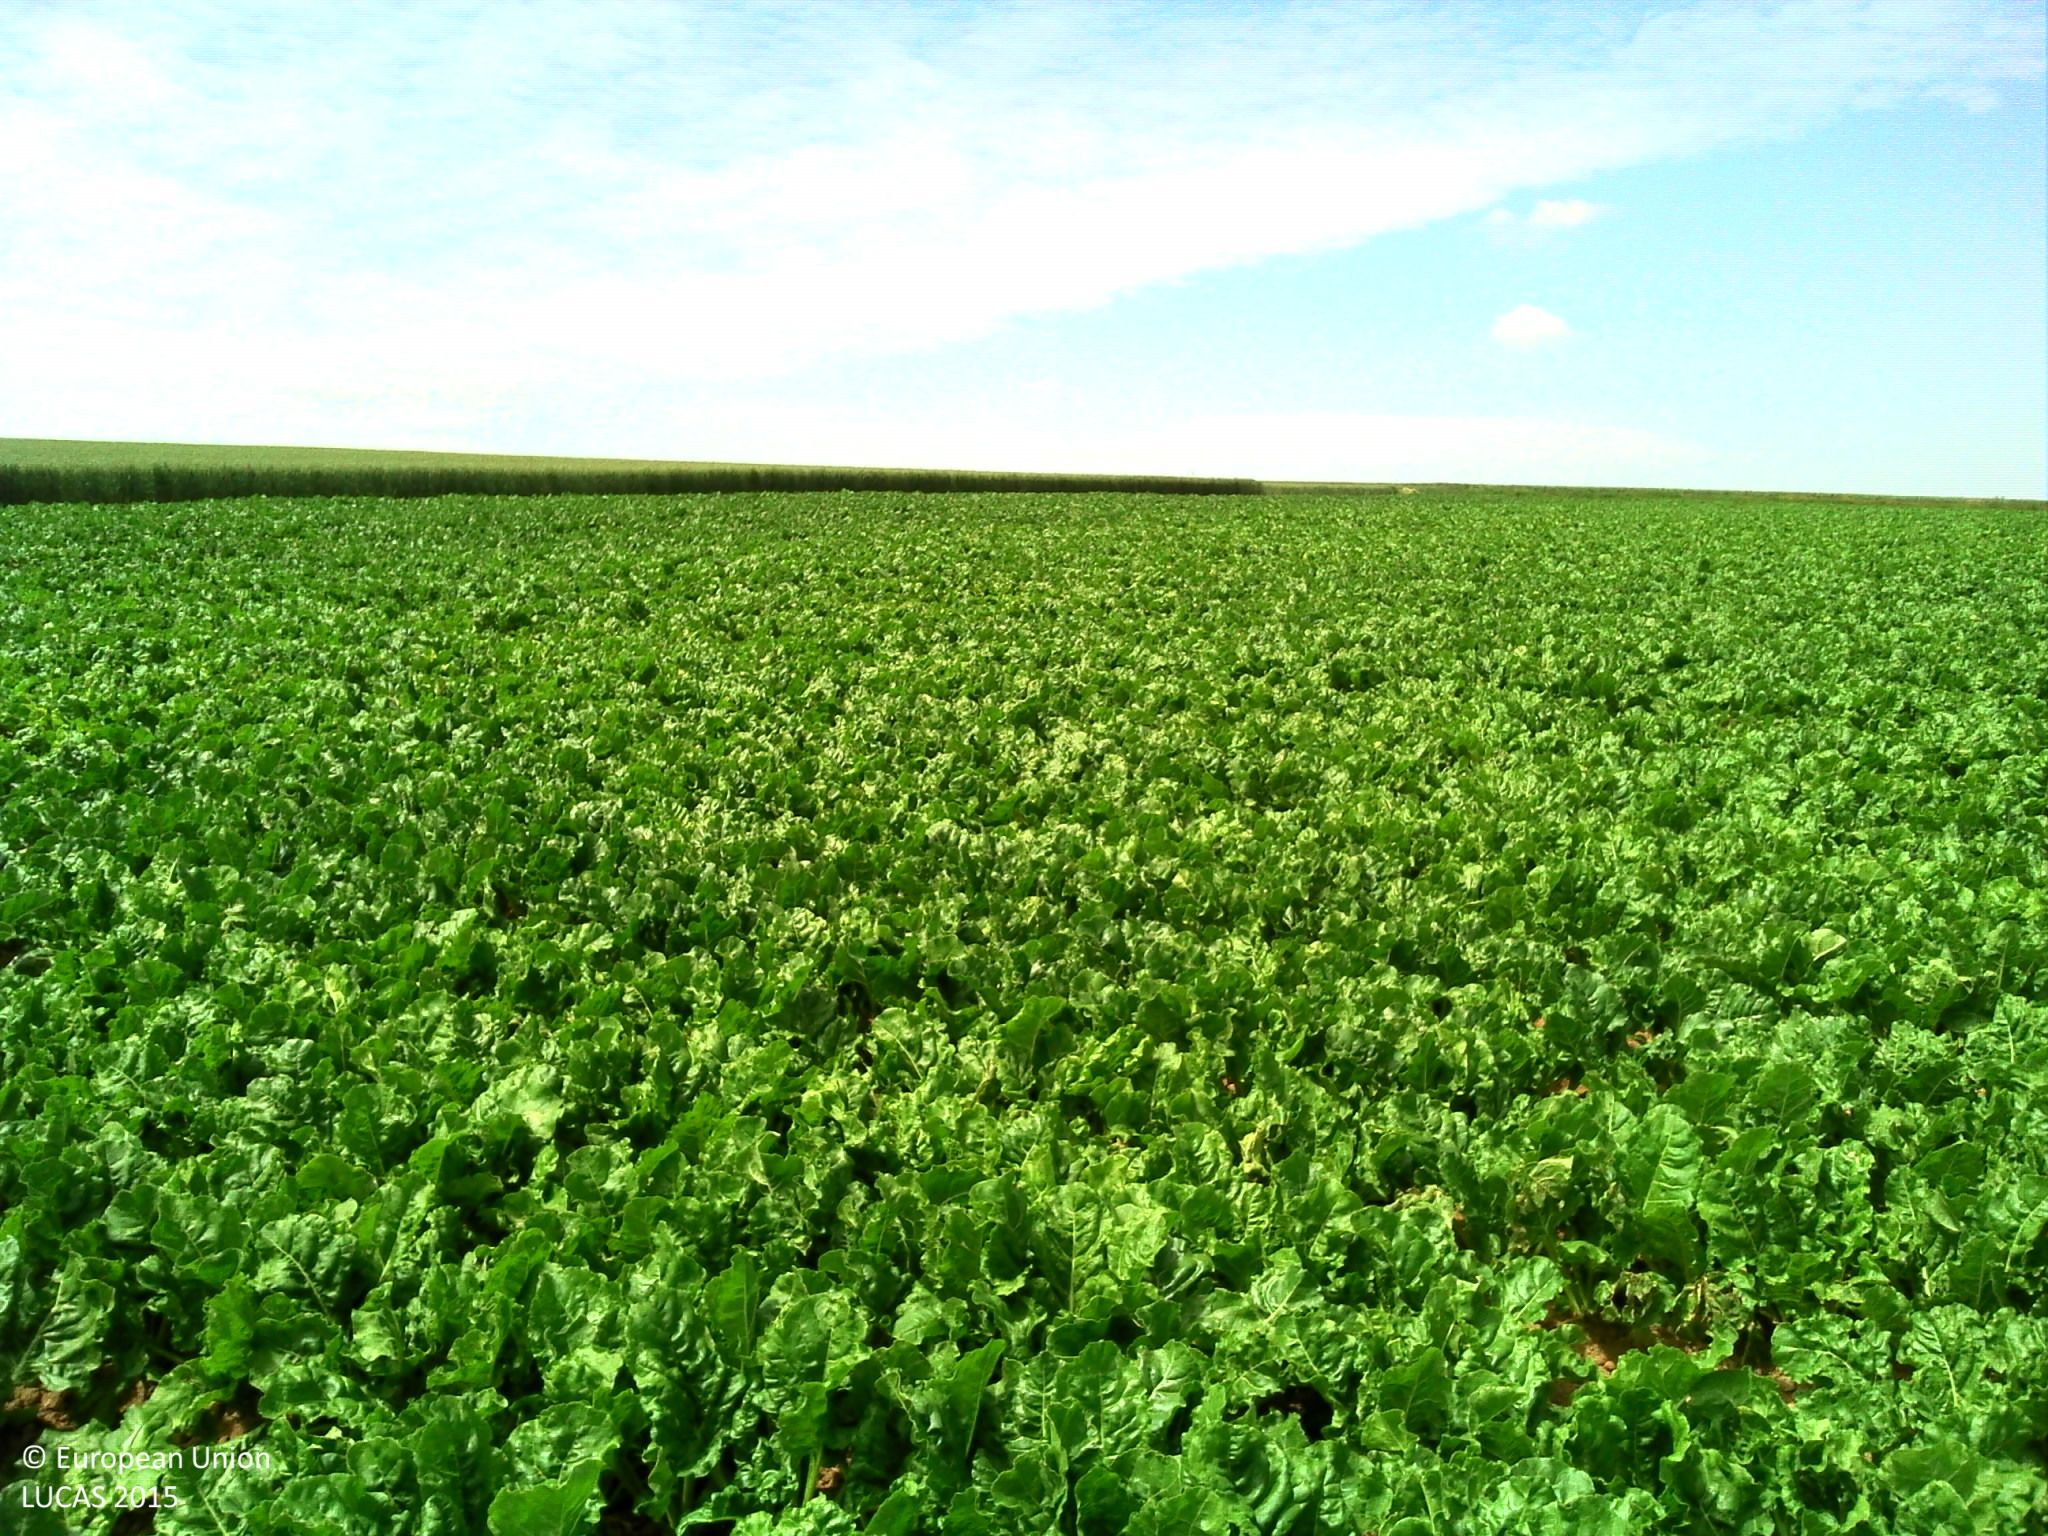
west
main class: Cropland
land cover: Sugar beet
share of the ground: > 75 %
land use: Agriculture (excluding fallow land and kitchen gardens)
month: June
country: FR
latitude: 50.7960
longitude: 2.1109
